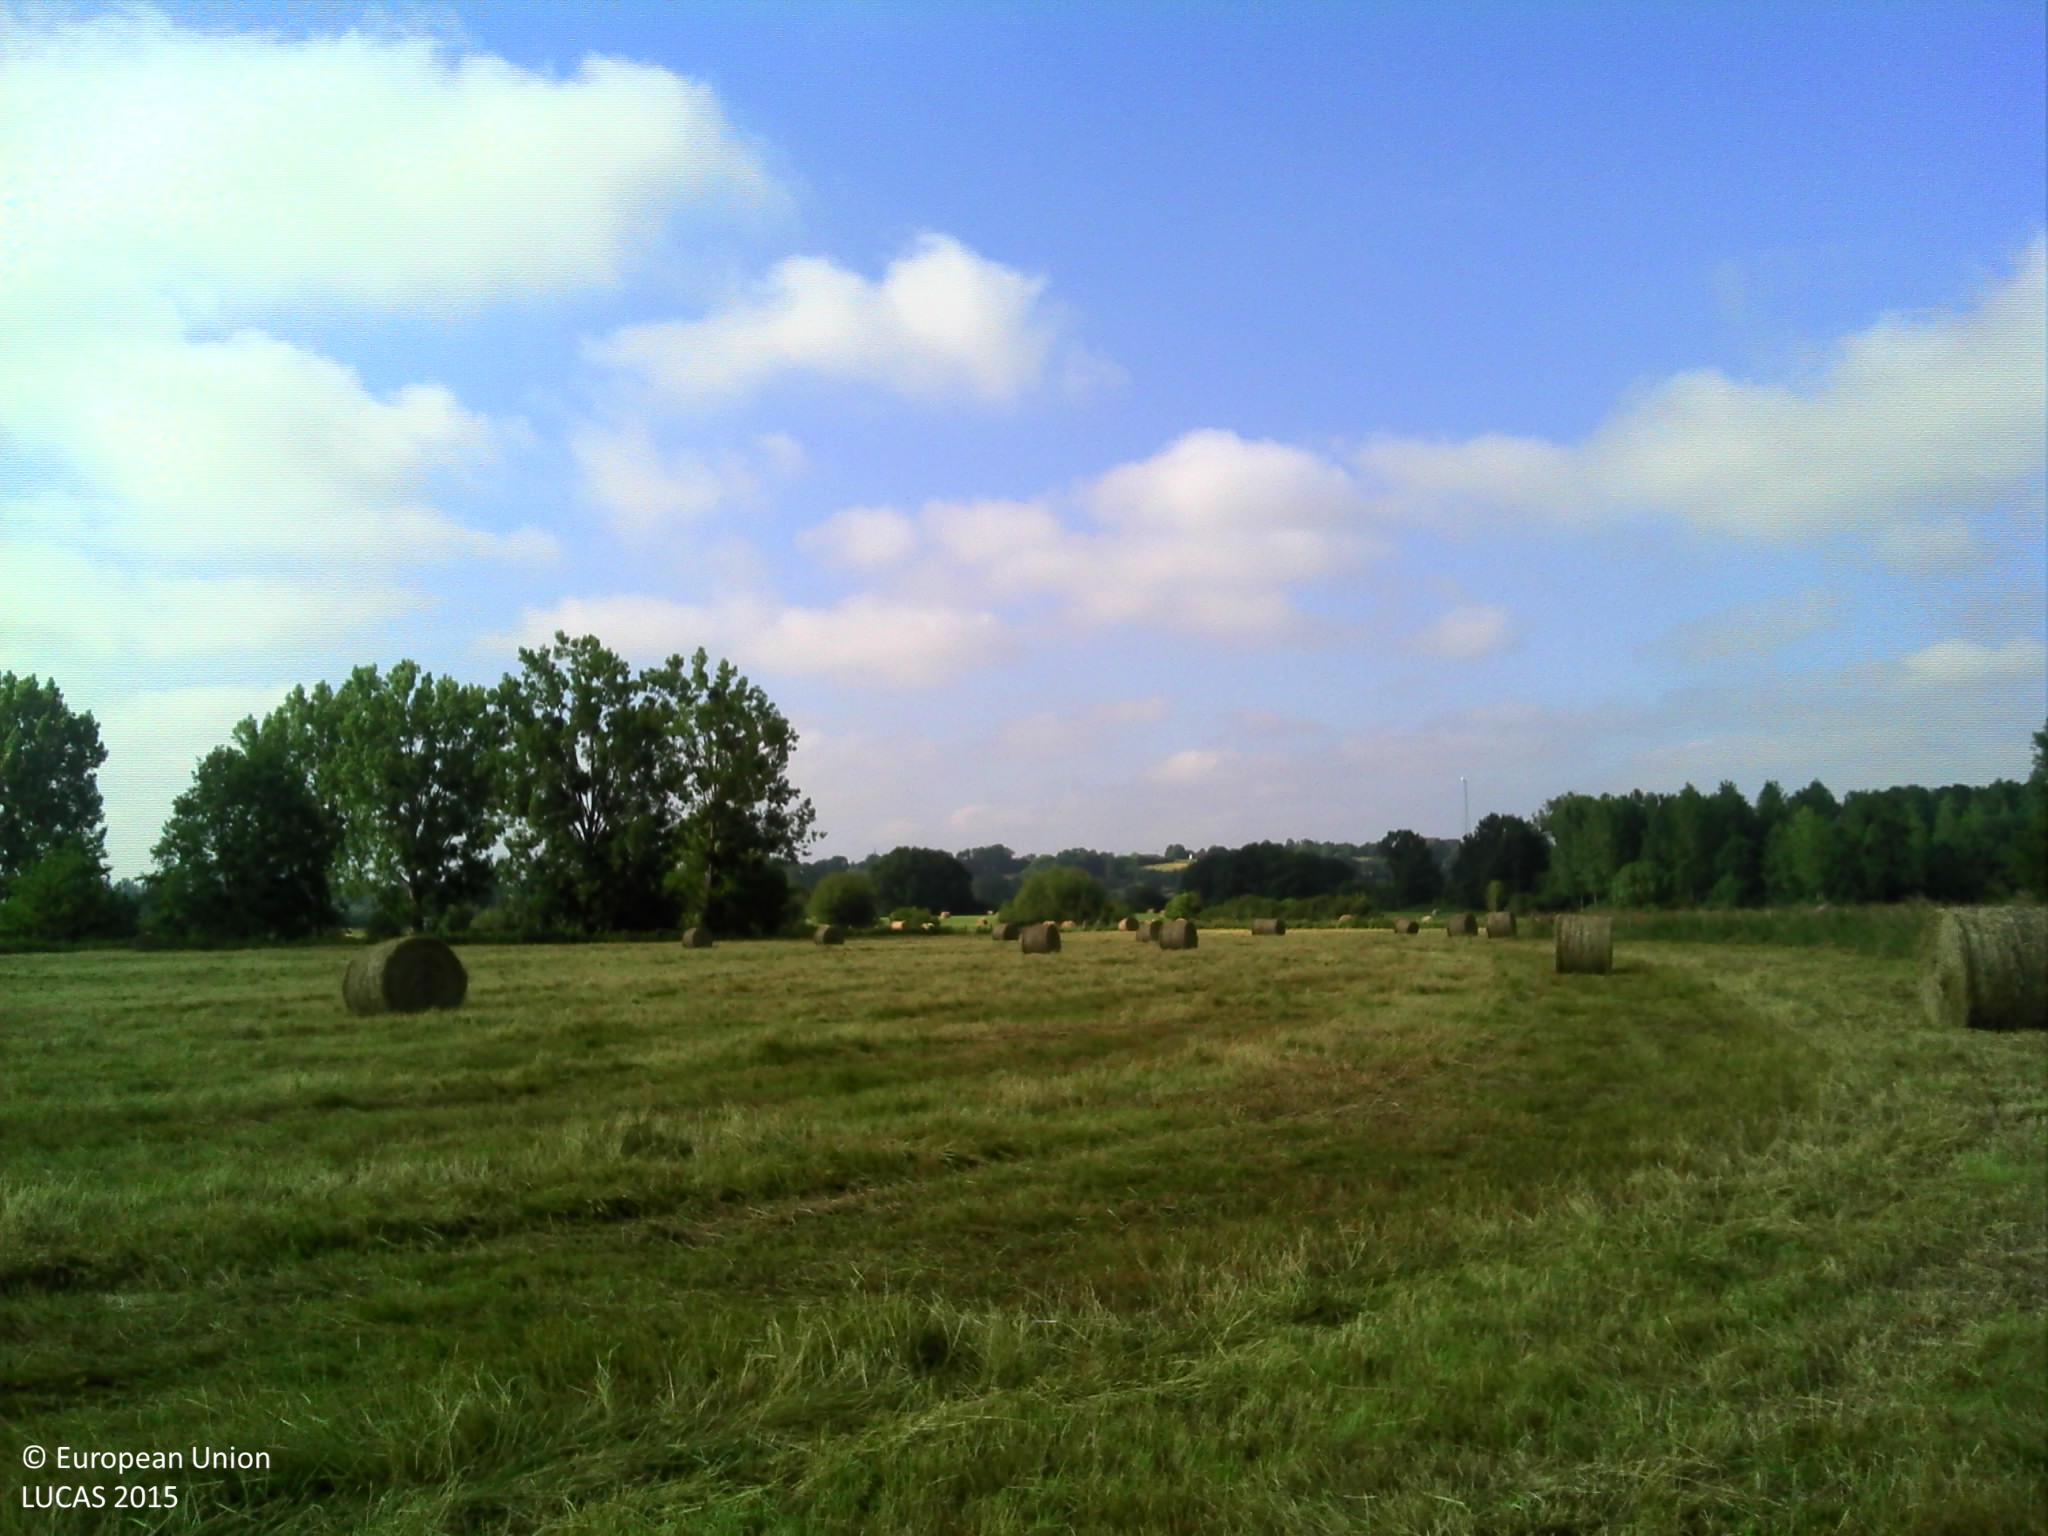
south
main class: Cropland
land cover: Maize
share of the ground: 25 - 50 %
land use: Agriculture (excluding fallow land and kitchen gardens)
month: June
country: FR
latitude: 48.1889
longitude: 0.2482
